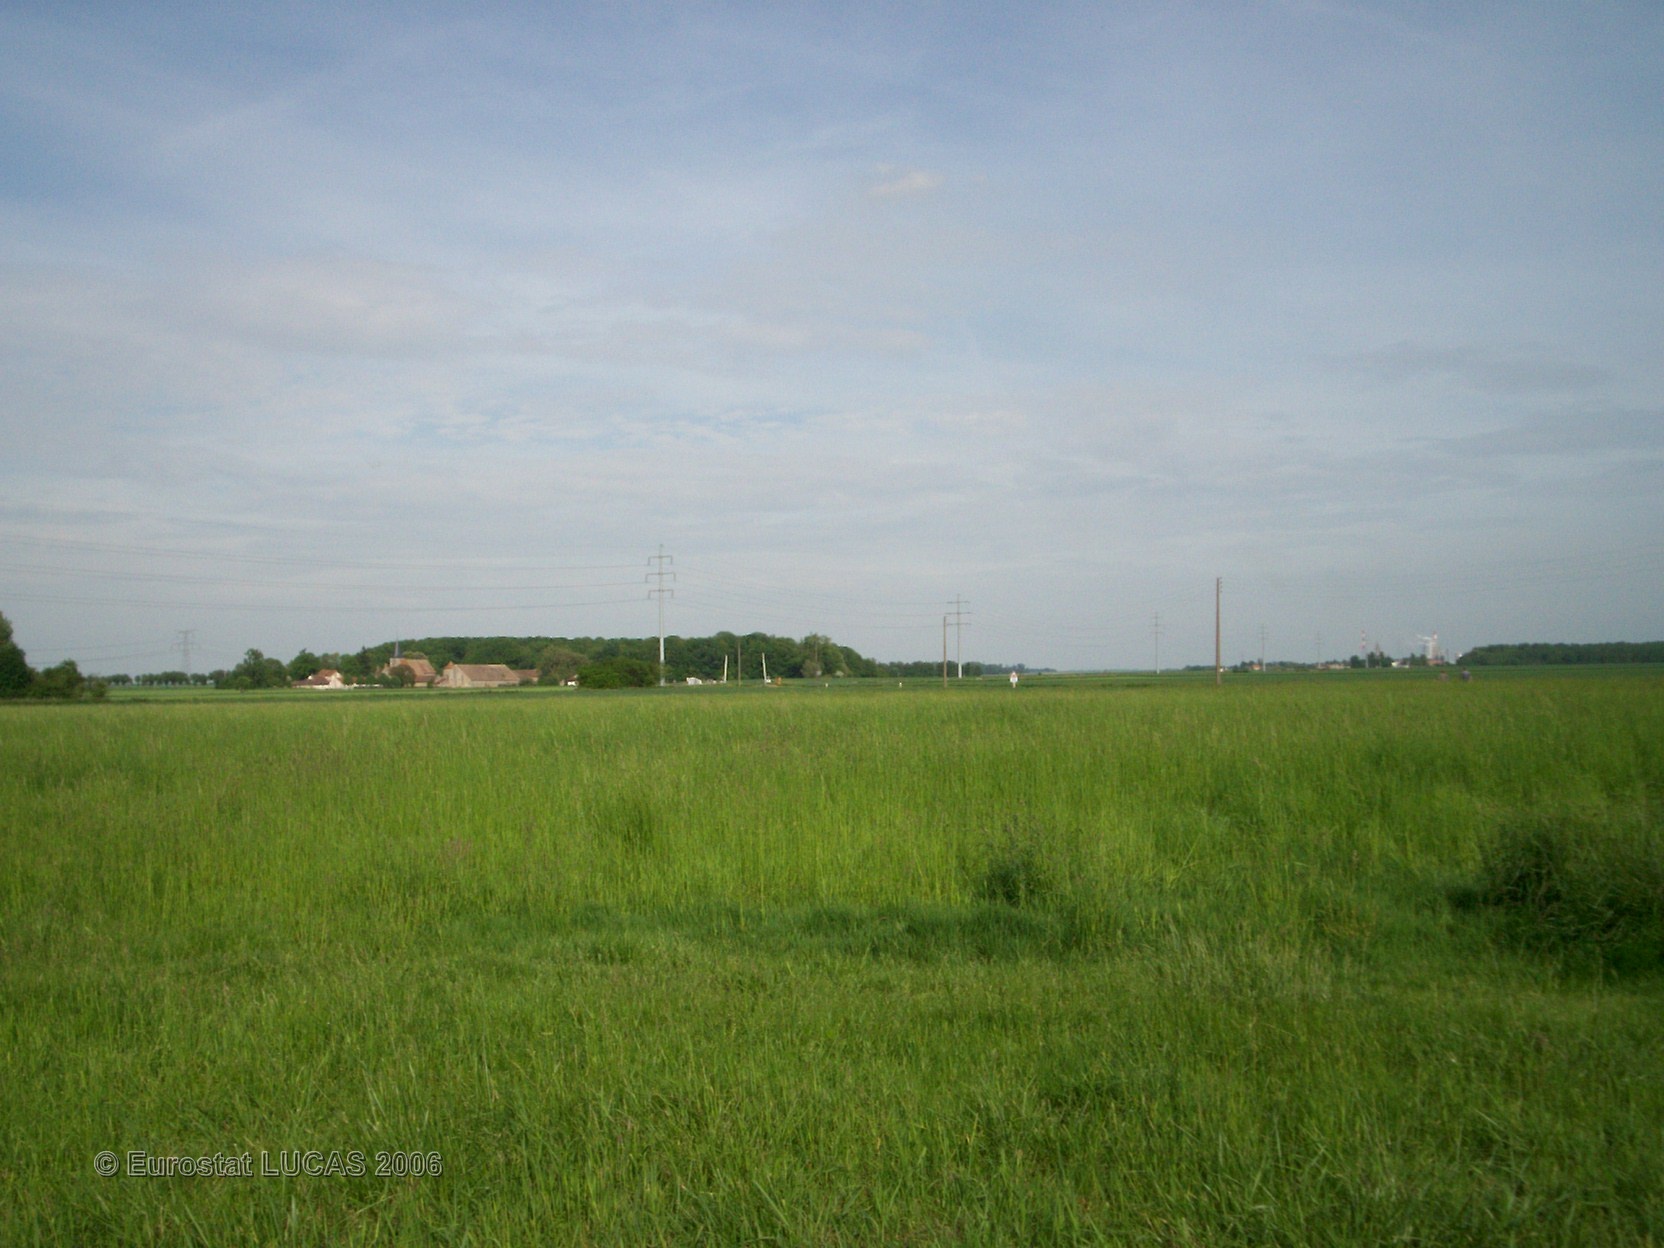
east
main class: Grassland
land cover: Grassland with sparse tree/shrub cover
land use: Amenities, museums, leisure
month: May
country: FR
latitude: 48.6085
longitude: 2.8979
